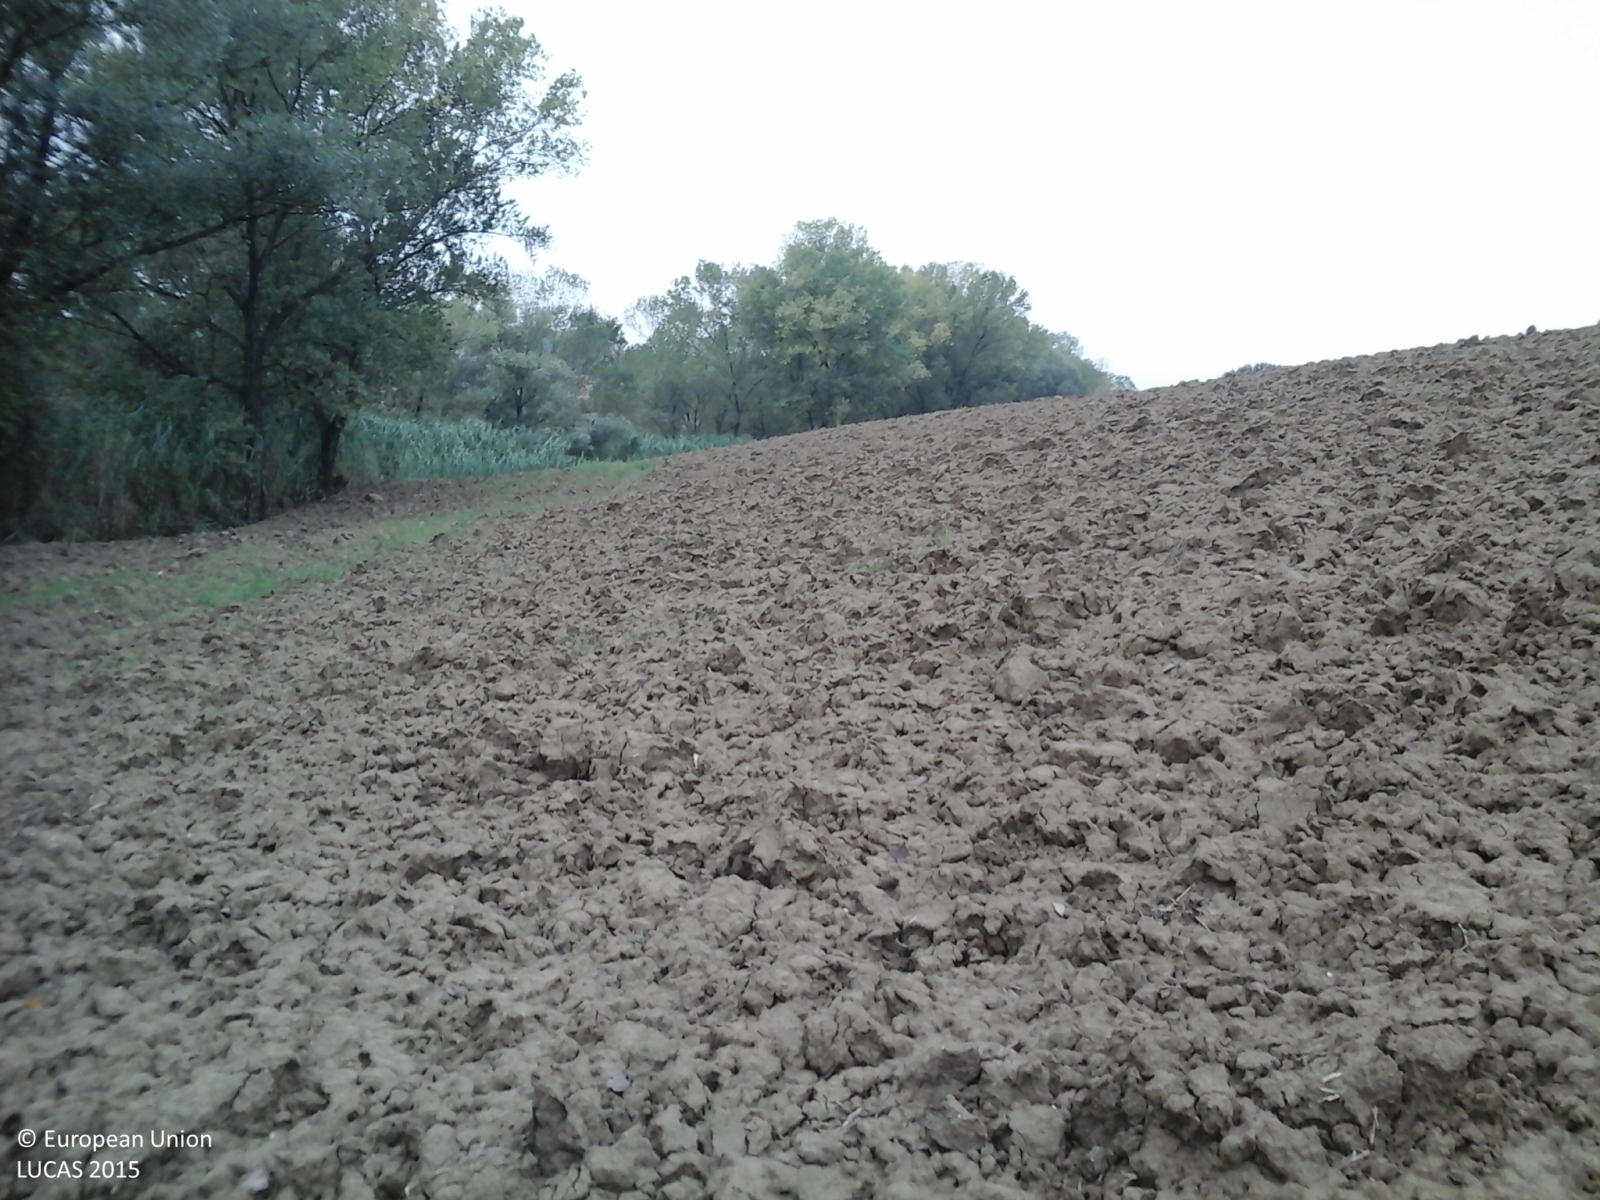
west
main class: Cropland
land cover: Durum wheat
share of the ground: < 10 %
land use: Agriculture (excluding fallow land and kitchen gardens)
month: October
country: IT
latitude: 43.6316
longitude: 13.2519
